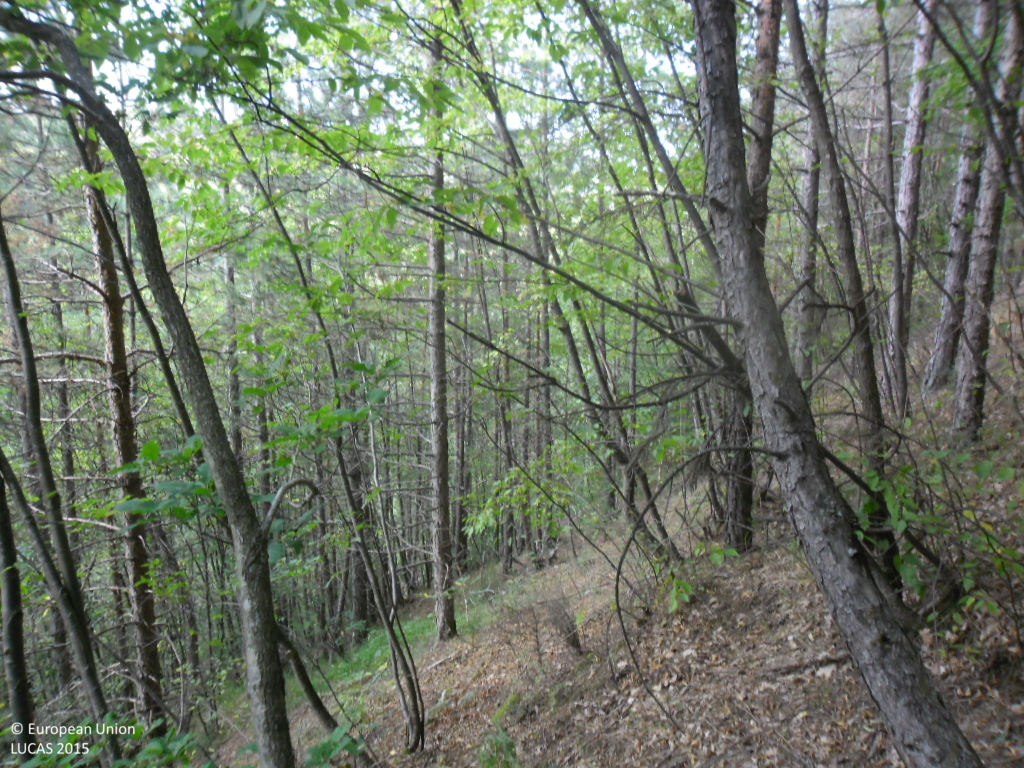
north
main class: Woodland
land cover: Pine dominated mixed woodland
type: hemiboreal forest and nemoral coniferous forest and mixed broadleaved-coniferous forest
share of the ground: > 75 %
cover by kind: coniferous forest trees 75 %, broadleaved forest trees 25 %
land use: Forestry
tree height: > 5 m
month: September
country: BG
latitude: 41.8080
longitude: 23.0329
